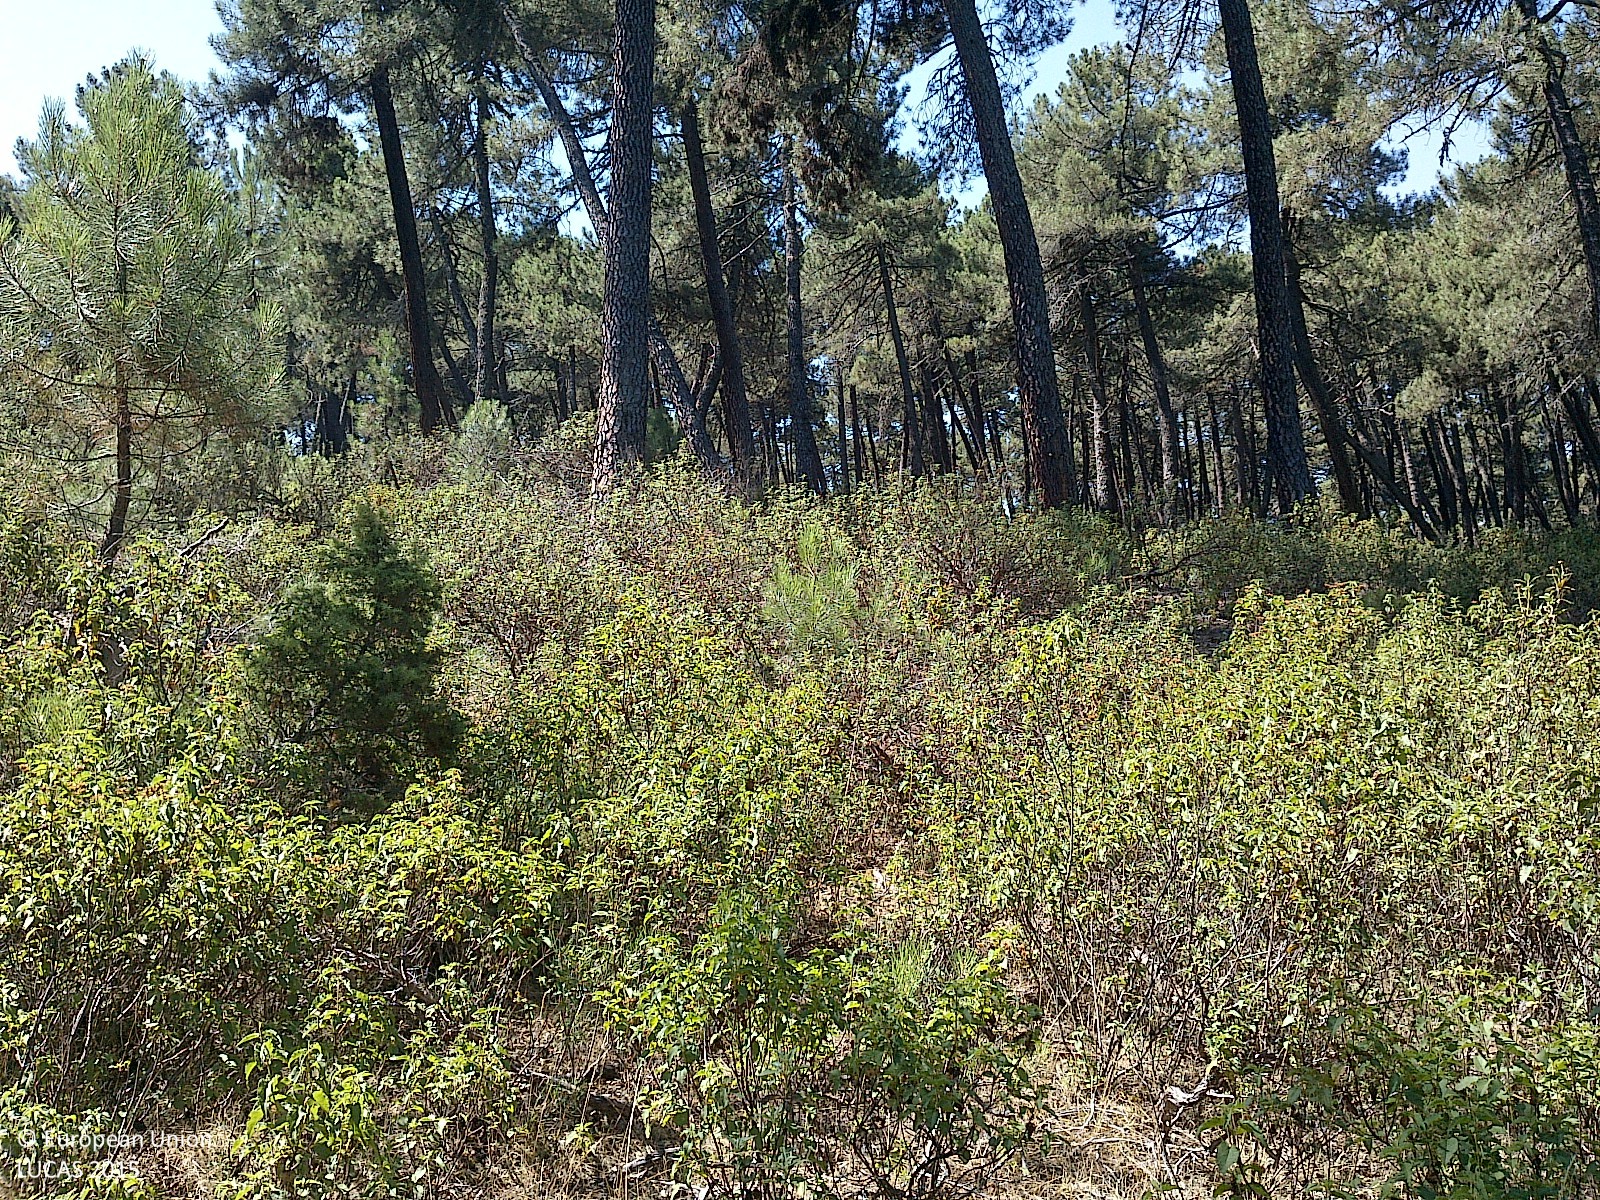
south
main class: Woodland
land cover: Pine dominated coniferous woodland
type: coniferous forest of the mediterranean region
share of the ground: 25 - 50 %
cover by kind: coniferous forest trees 40 %, shrubs 30 %, herbaceous plants 30 %
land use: Forestry
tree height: > 5 m
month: July
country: ES
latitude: 41.7892
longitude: -3.1752
